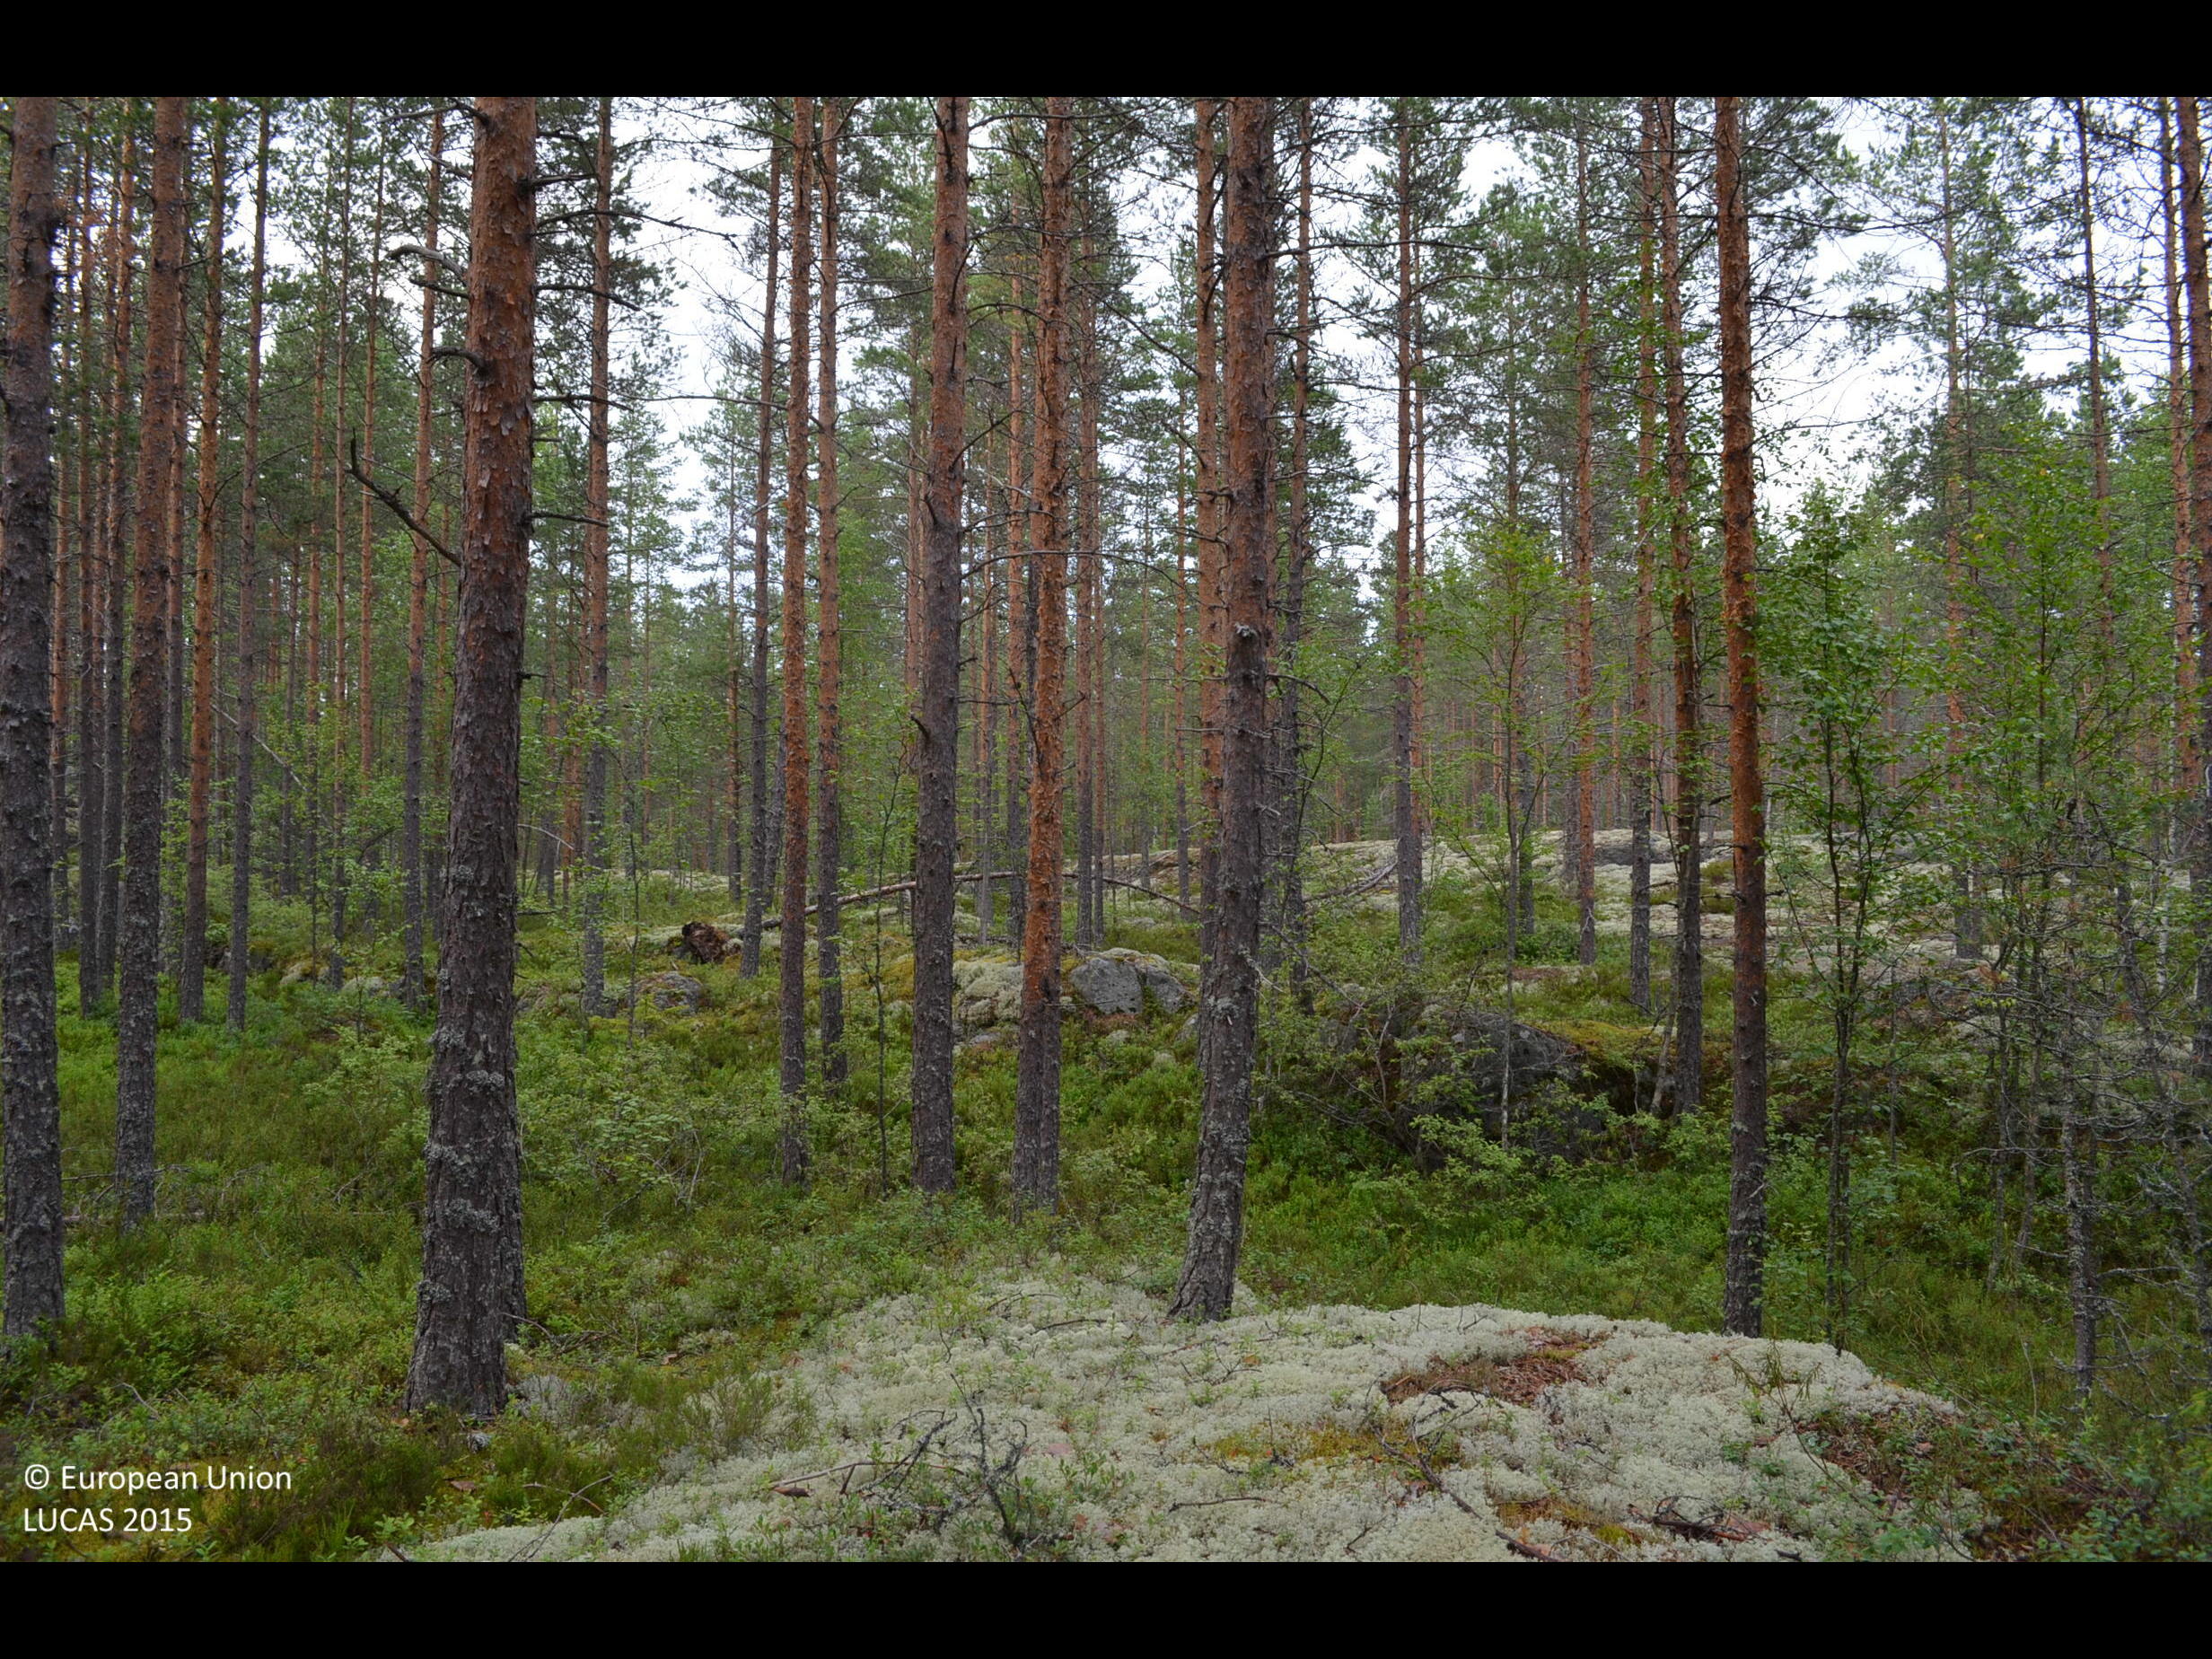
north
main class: Woodland
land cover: Pine dominated coniferous woodland
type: boreal forest
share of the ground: 50 - 75 %
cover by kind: coniferous forest trees 60 %, shrubs 20 %, lichens and mosses 20 %
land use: Forestry
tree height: > 5 m
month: July
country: FI
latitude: 62.2085
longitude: 23.4340
